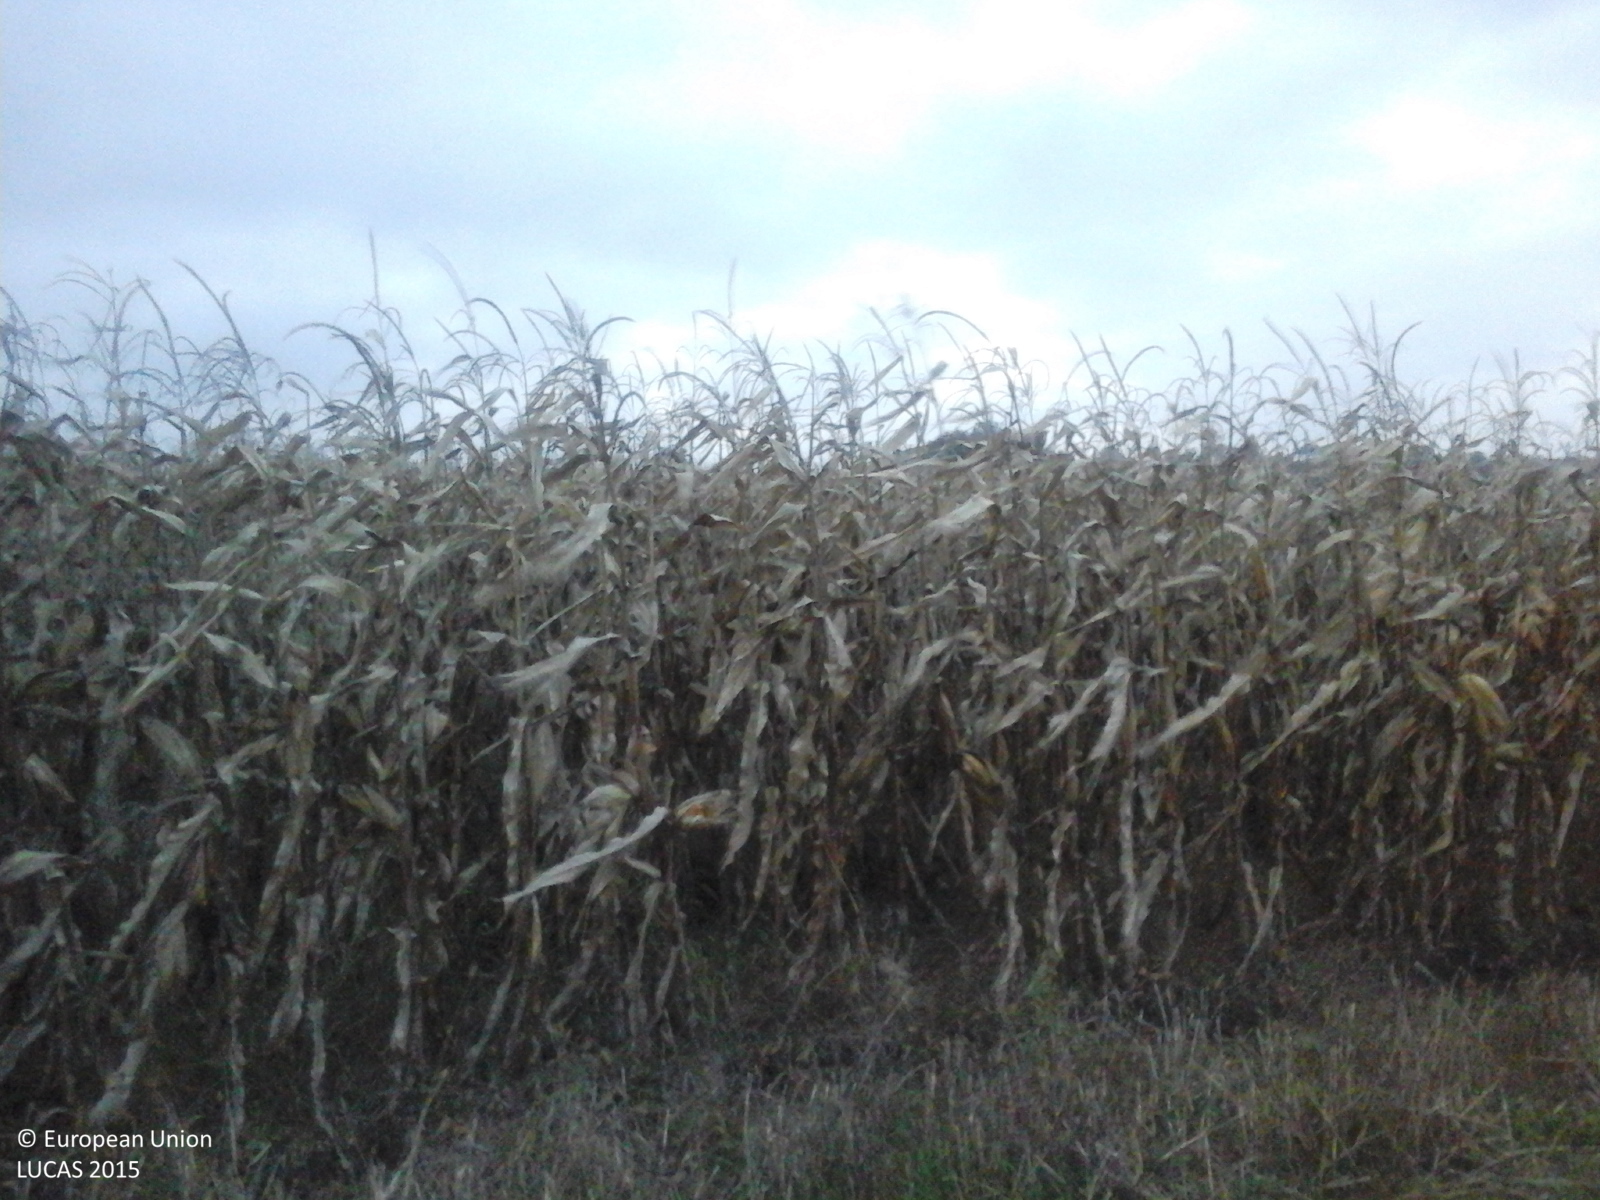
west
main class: Grassland
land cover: Grassland without tree/shrub cover
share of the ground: > 75 %
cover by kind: herbaceous plants 100 %
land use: Agriculture (excluding fallow land and kitchen gardens)
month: October
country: RO
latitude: 46.3212
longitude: 23.8529
